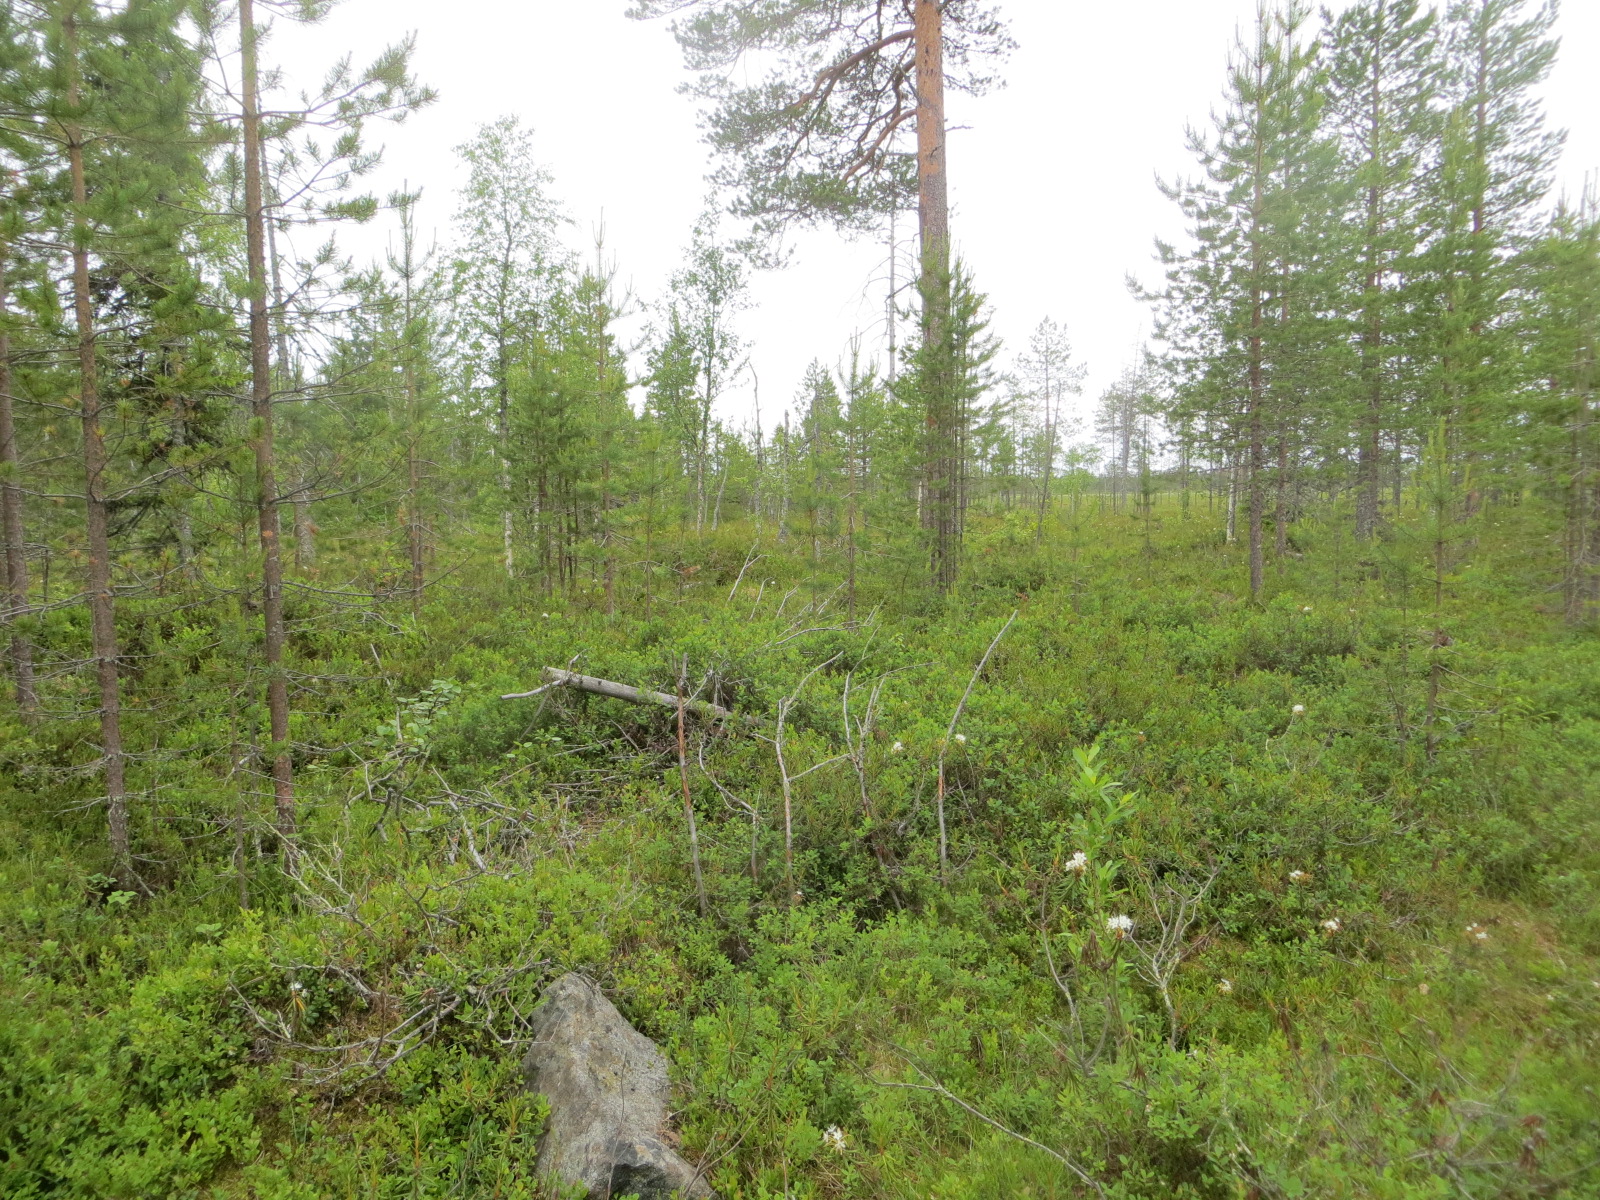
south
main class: Woodland
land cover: Pine dominated coniferous woodland
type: boreal forest
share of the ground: > 75 %
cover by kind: coniferous forest trees 75 %, shrubs 20 %, broadleaved forest trees 5 %
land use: Forestry
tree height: > 5 m
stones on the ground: 25 - 50 %
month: July
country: FI
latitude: 65.5765
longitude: 25.8416
